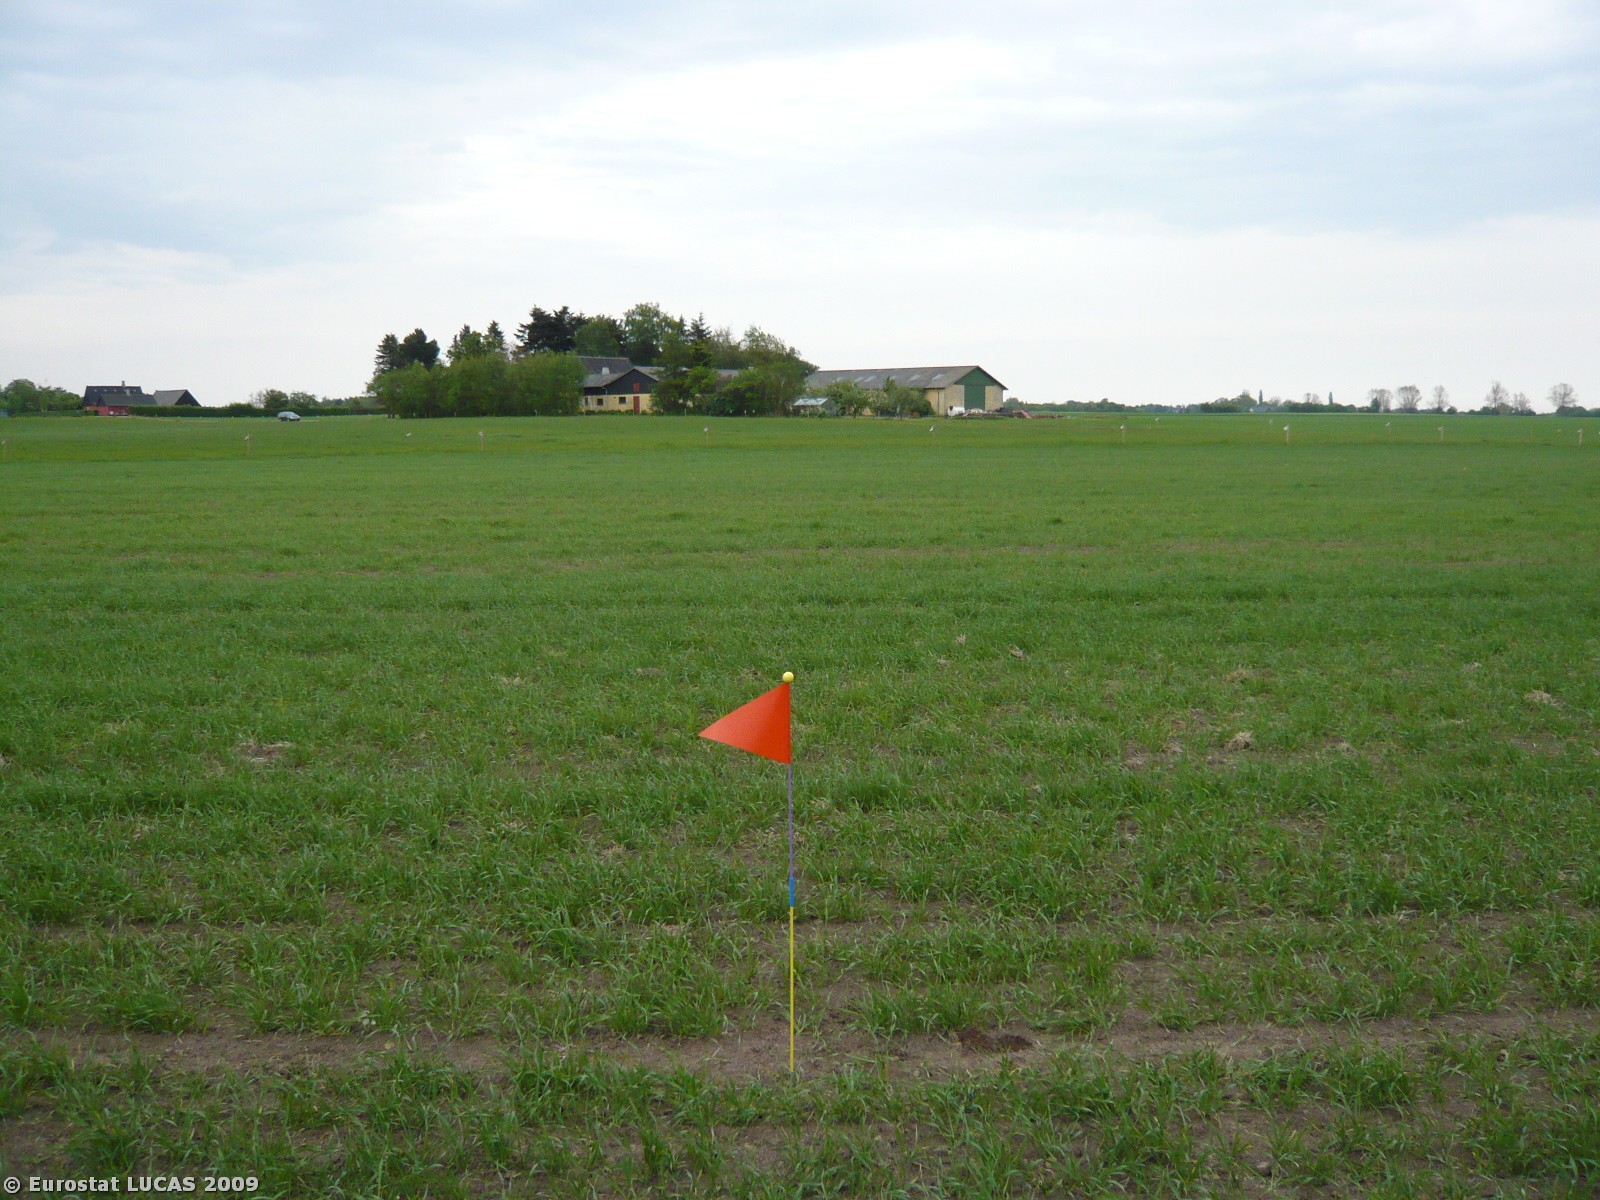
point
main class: Cropland
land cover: Barley
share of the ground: 50 - 75 %
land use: Agriculture (excluding fallow land and kitchen gardens)
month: May
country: DK
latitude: 55.3604
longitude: 12.1595
